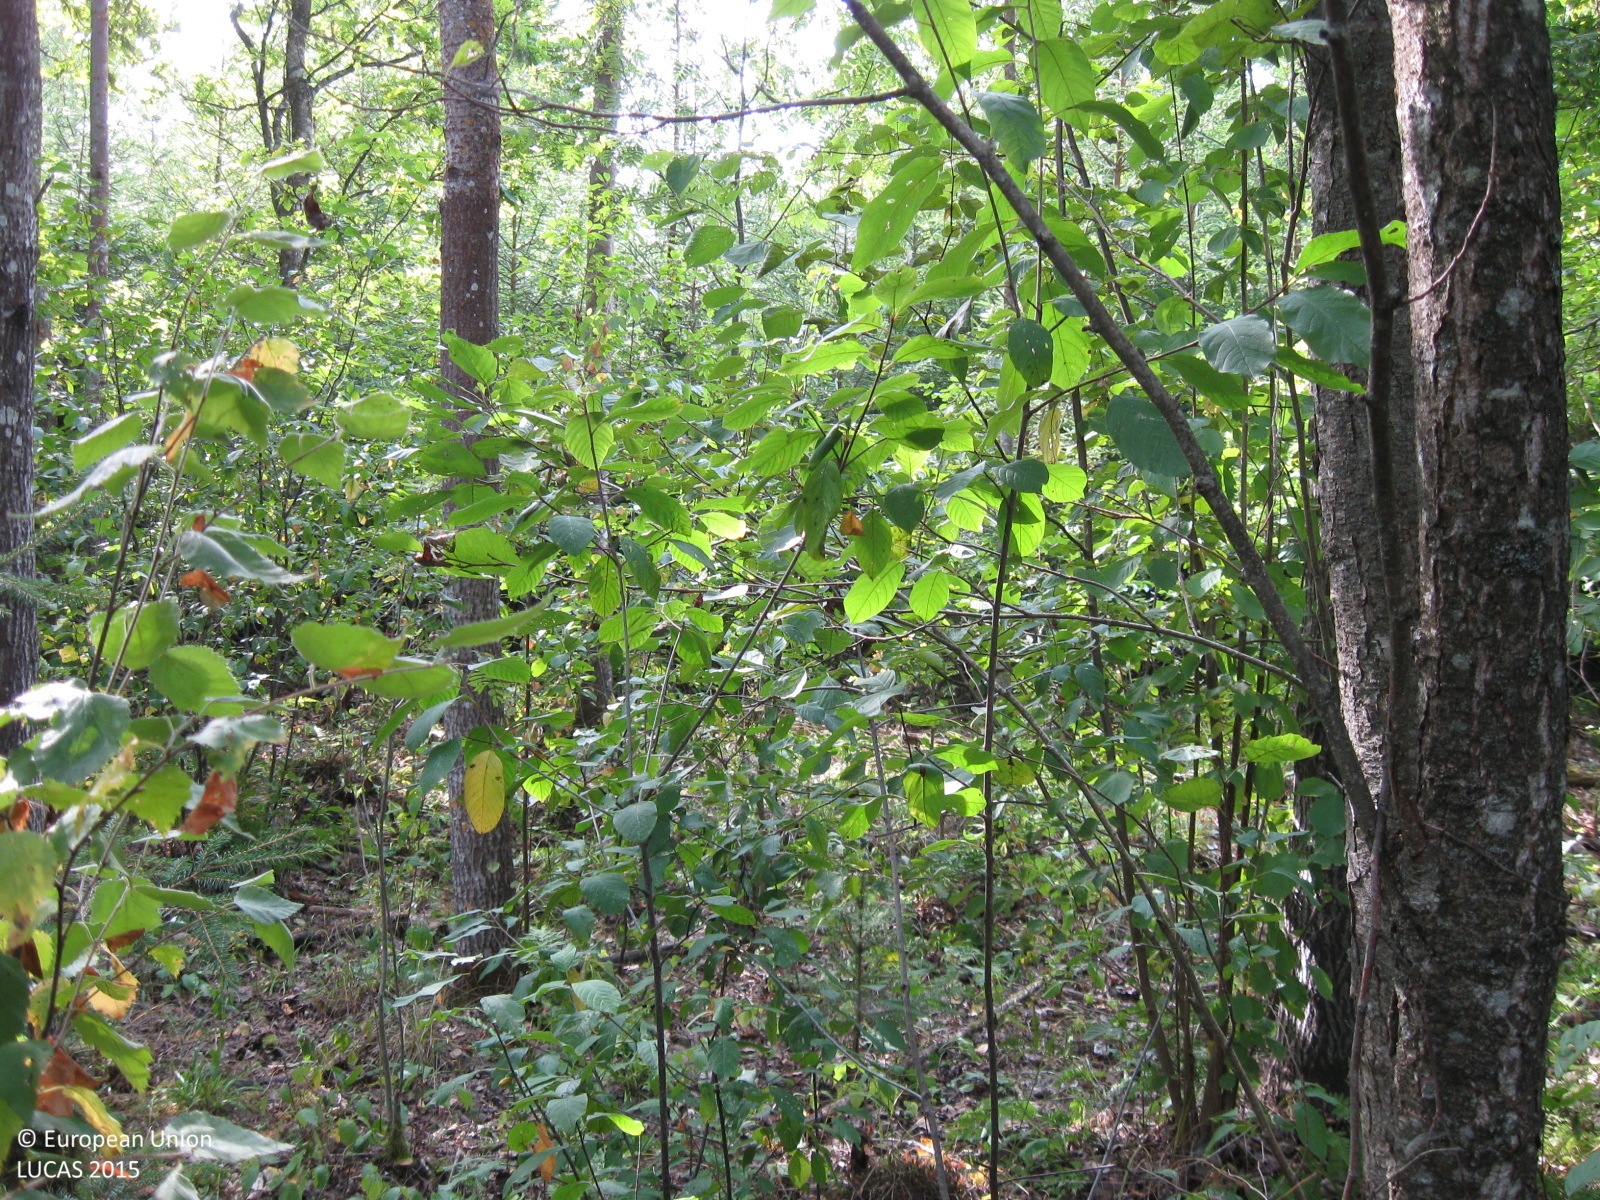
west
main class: Woodland
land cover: Broadleaved woodland
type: non-riverine alder, birch or aspen forest
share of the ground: > 75 %
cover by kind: broadleaved forest trees 85 %, coniferous forest trees 10 %, herbaceous plants 5 %
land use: Forestry
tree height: > 5 m
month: August
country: LT
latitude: 55.2604
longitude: 22.8927
